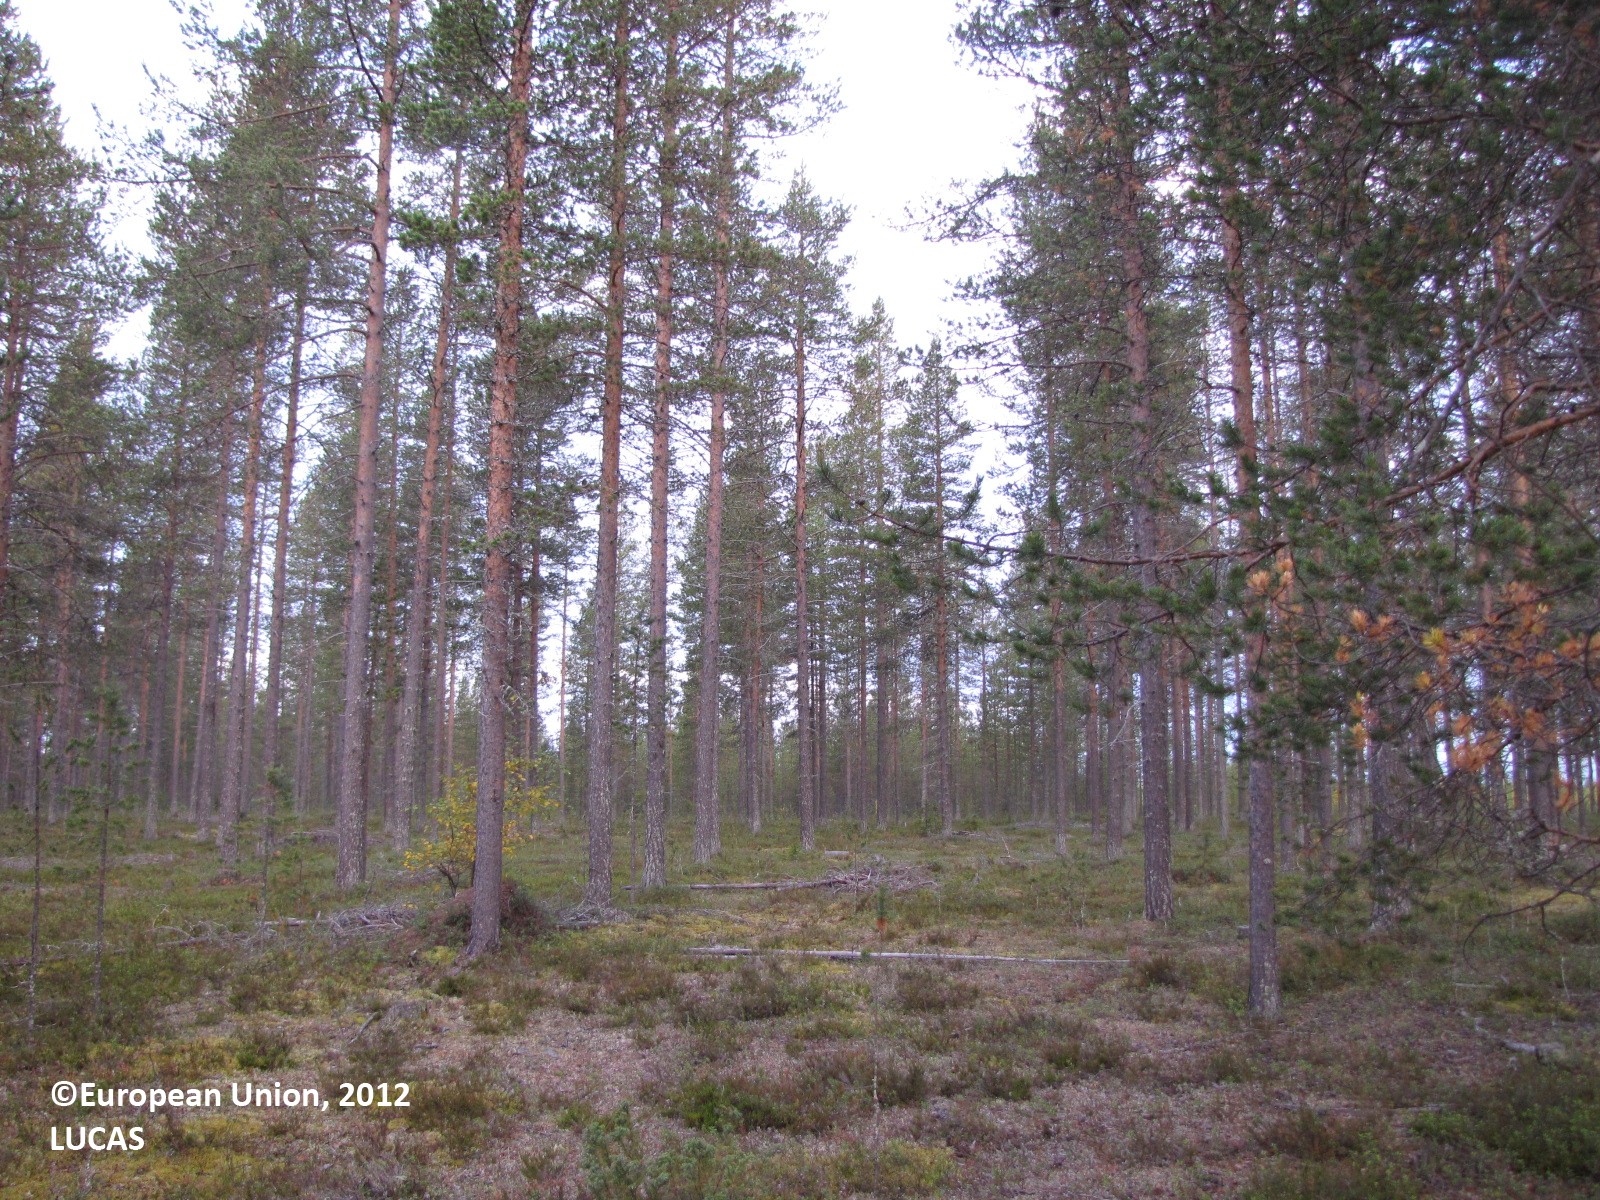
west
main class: Woodland
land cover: Pine dominated coniferous woodland
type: boreal forest
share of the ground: 50 - 75 %
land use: Forestry
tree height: > 5 m
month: September
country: FI
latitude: 67.3139
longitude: 24.8870
